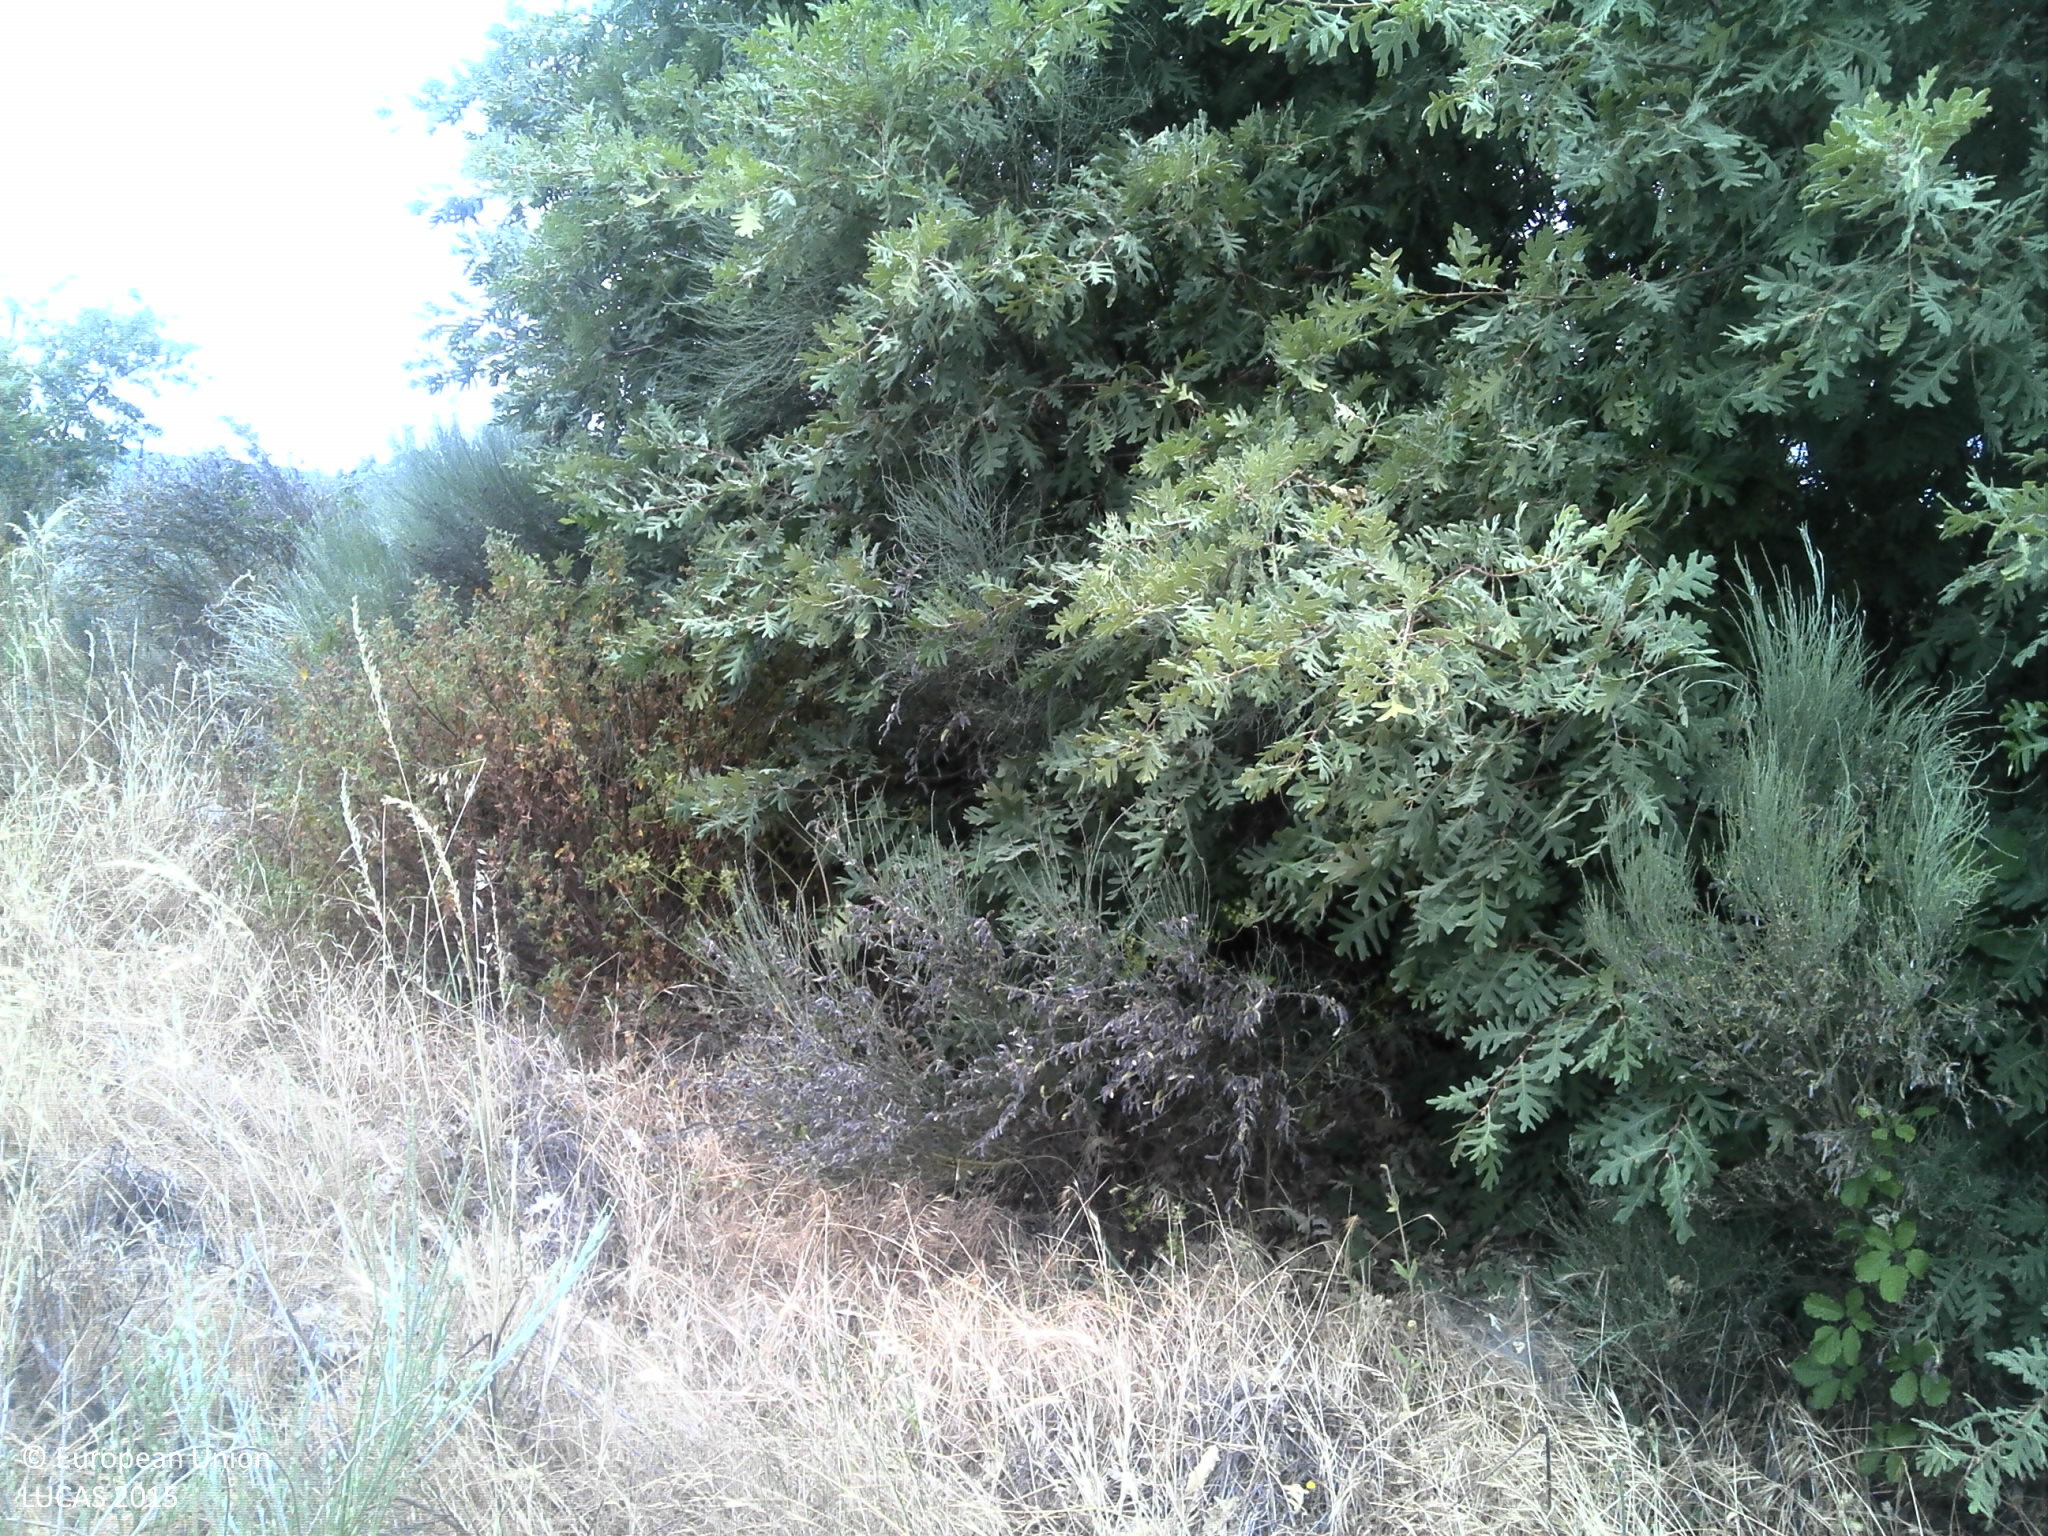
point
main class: Shrubland
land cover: Shrubland with sparse tree cover
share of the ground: 50 - 75 %
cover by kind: shrubs 55 %, herbaceous plants 30 %, broadleaved forest trees 5 %, unconsolidated bare surface 5 %
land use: Abandoned areas
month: June
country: PT
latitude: 40.3134
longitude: -7.2465
